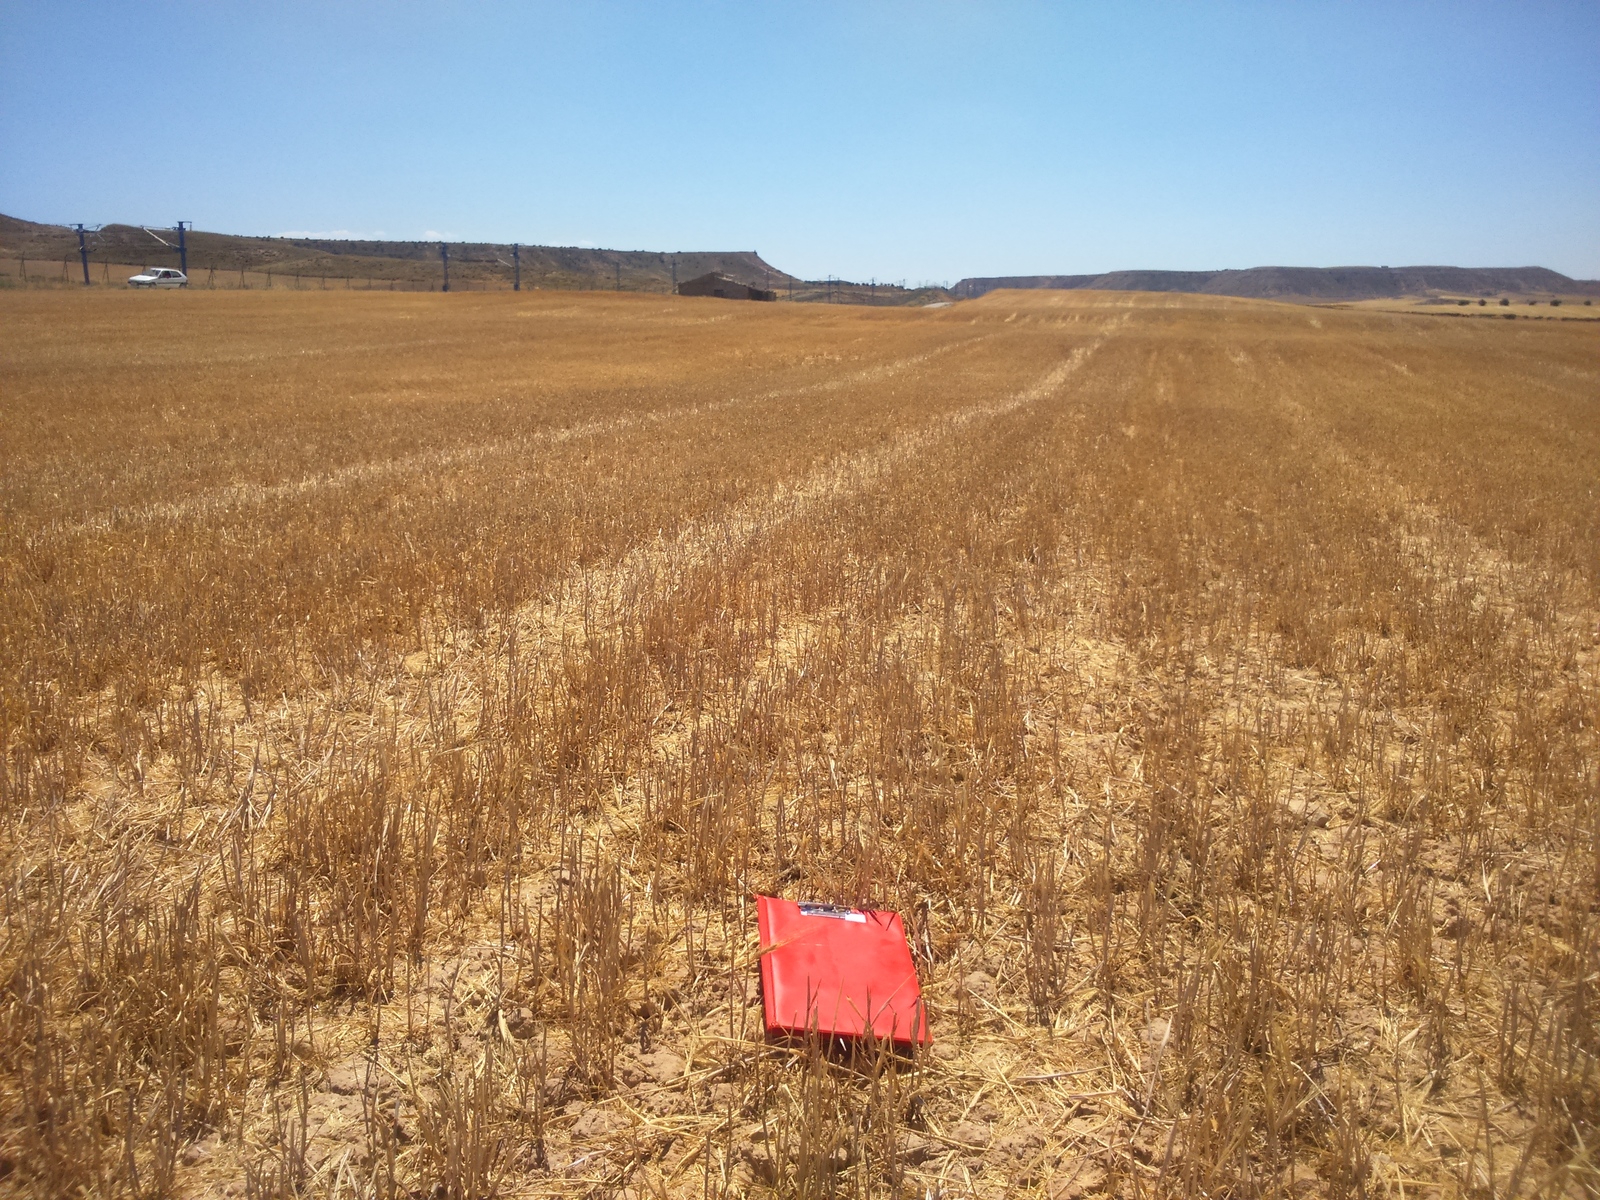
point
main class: Cropland
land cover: Barley
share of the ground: < 10 %
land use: Agriculture (excluding fallow land and kitchen gardens)
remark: Harvested field
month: June
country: ES
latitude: 41.5669
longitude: 0.0921
